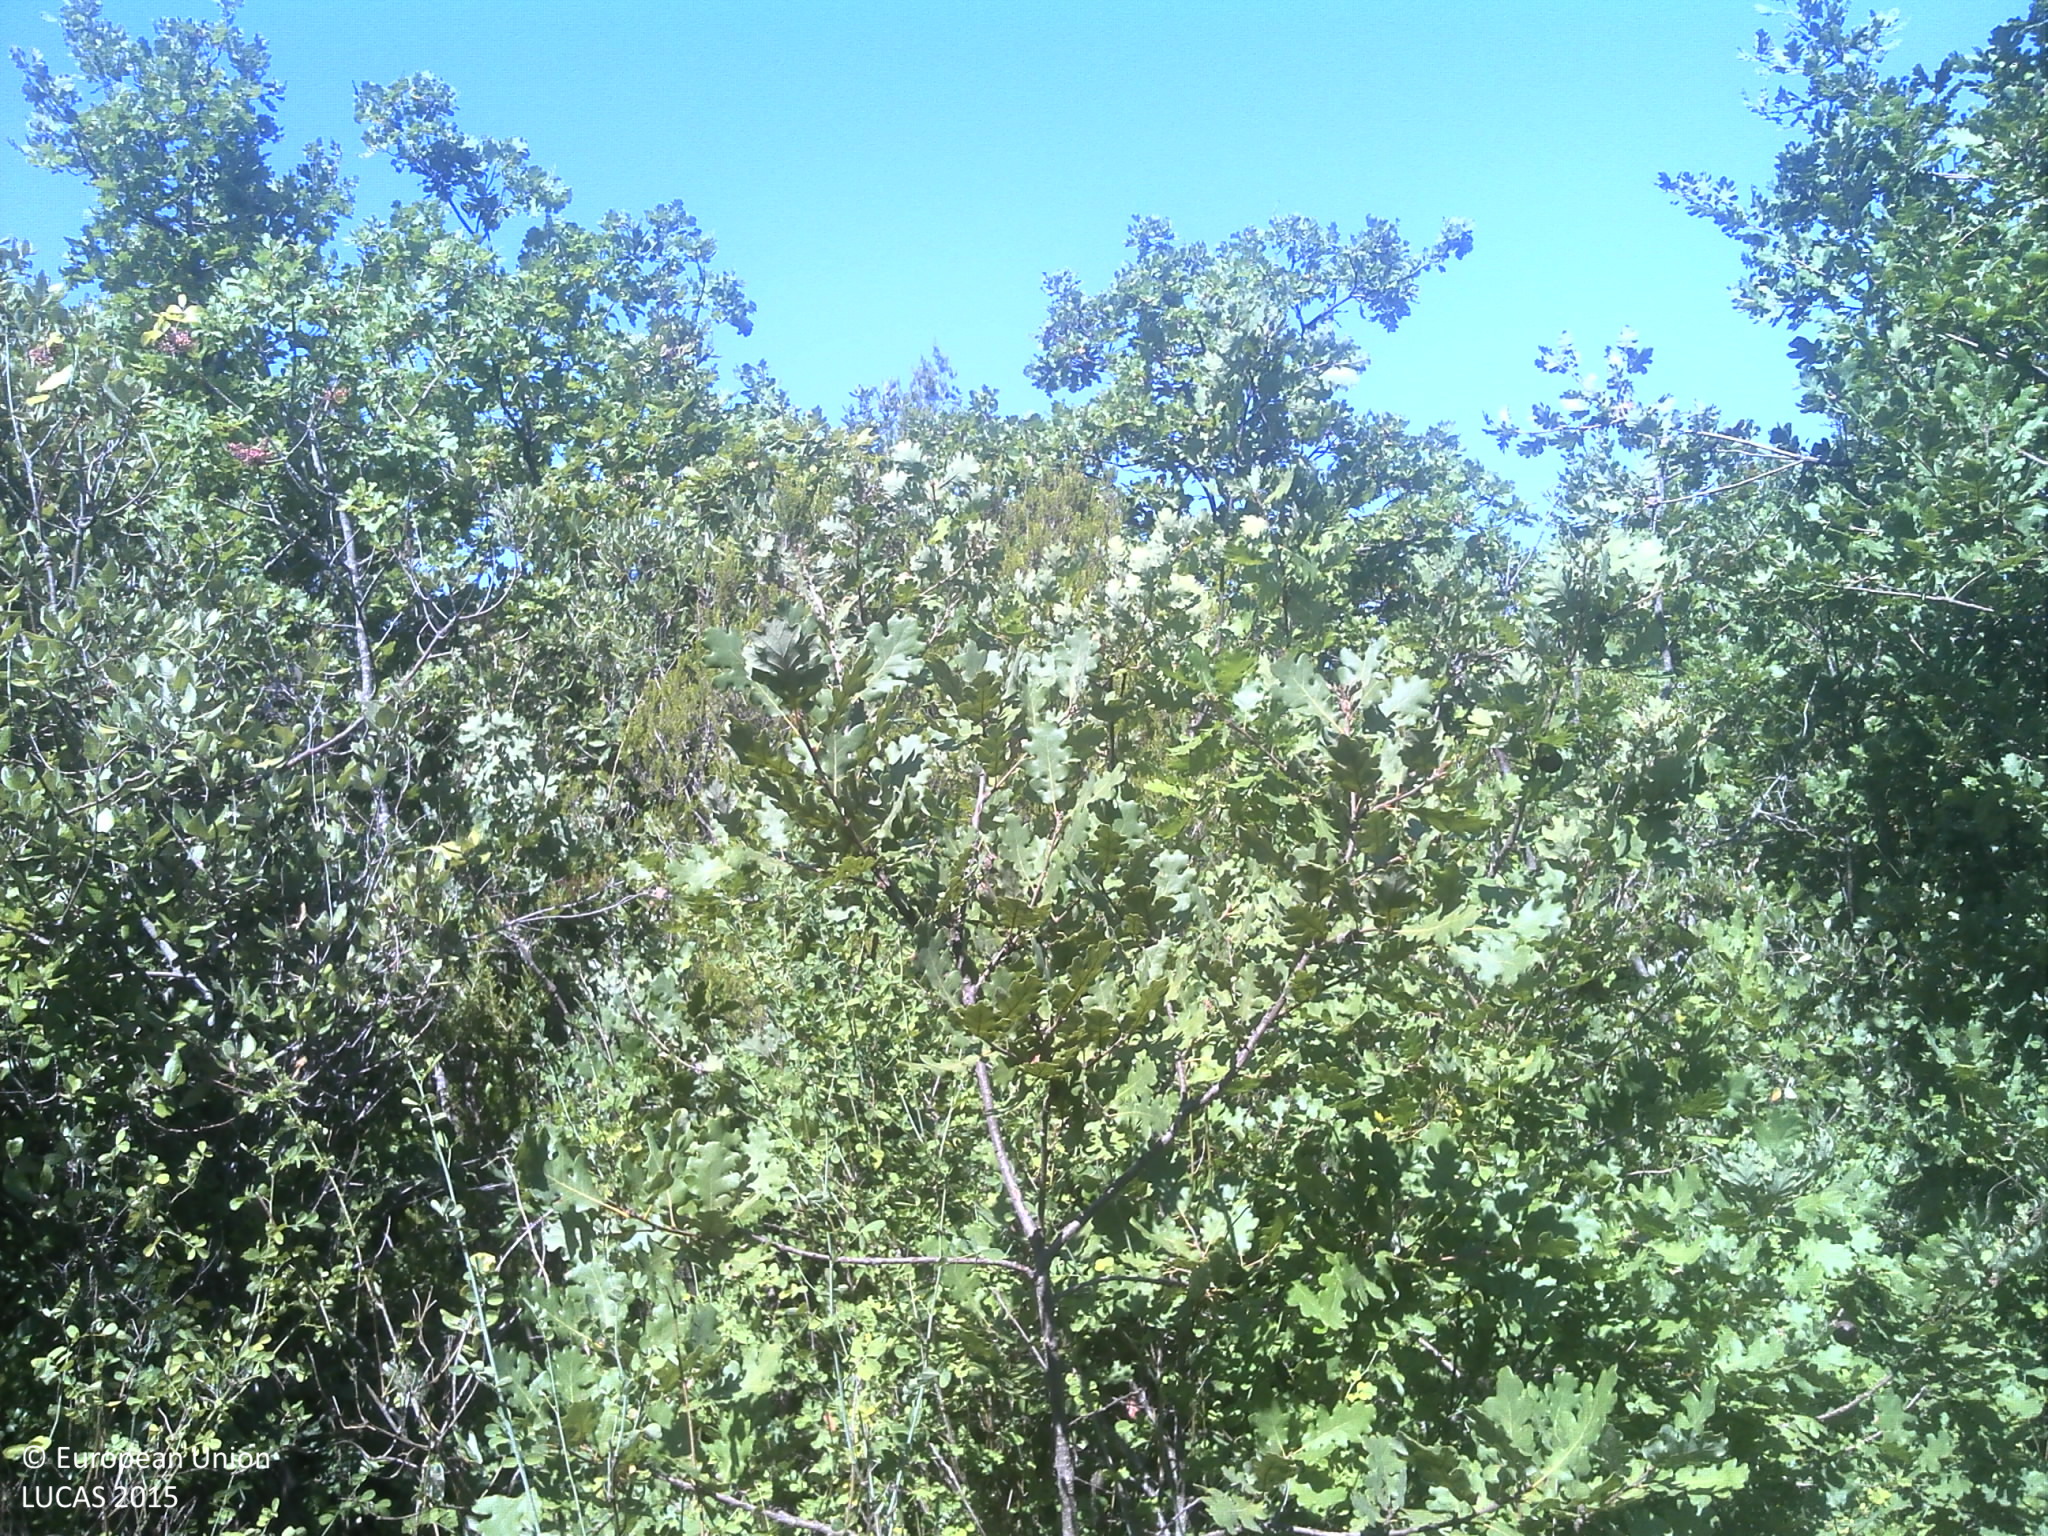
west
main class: Woodland
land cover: Broadleaved woodland
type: thermophilous deciduous forest
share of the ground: > 75 %
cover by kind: shrubs 65 %, broadleaved forest trees 20 %, unconsolidated bare surface 10 %, coniferous forest trees 5 %
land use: Semi-natural and natural areas not in use
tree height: > 5 m
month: August
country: HR
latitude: 43.9164
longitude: 15.4834
